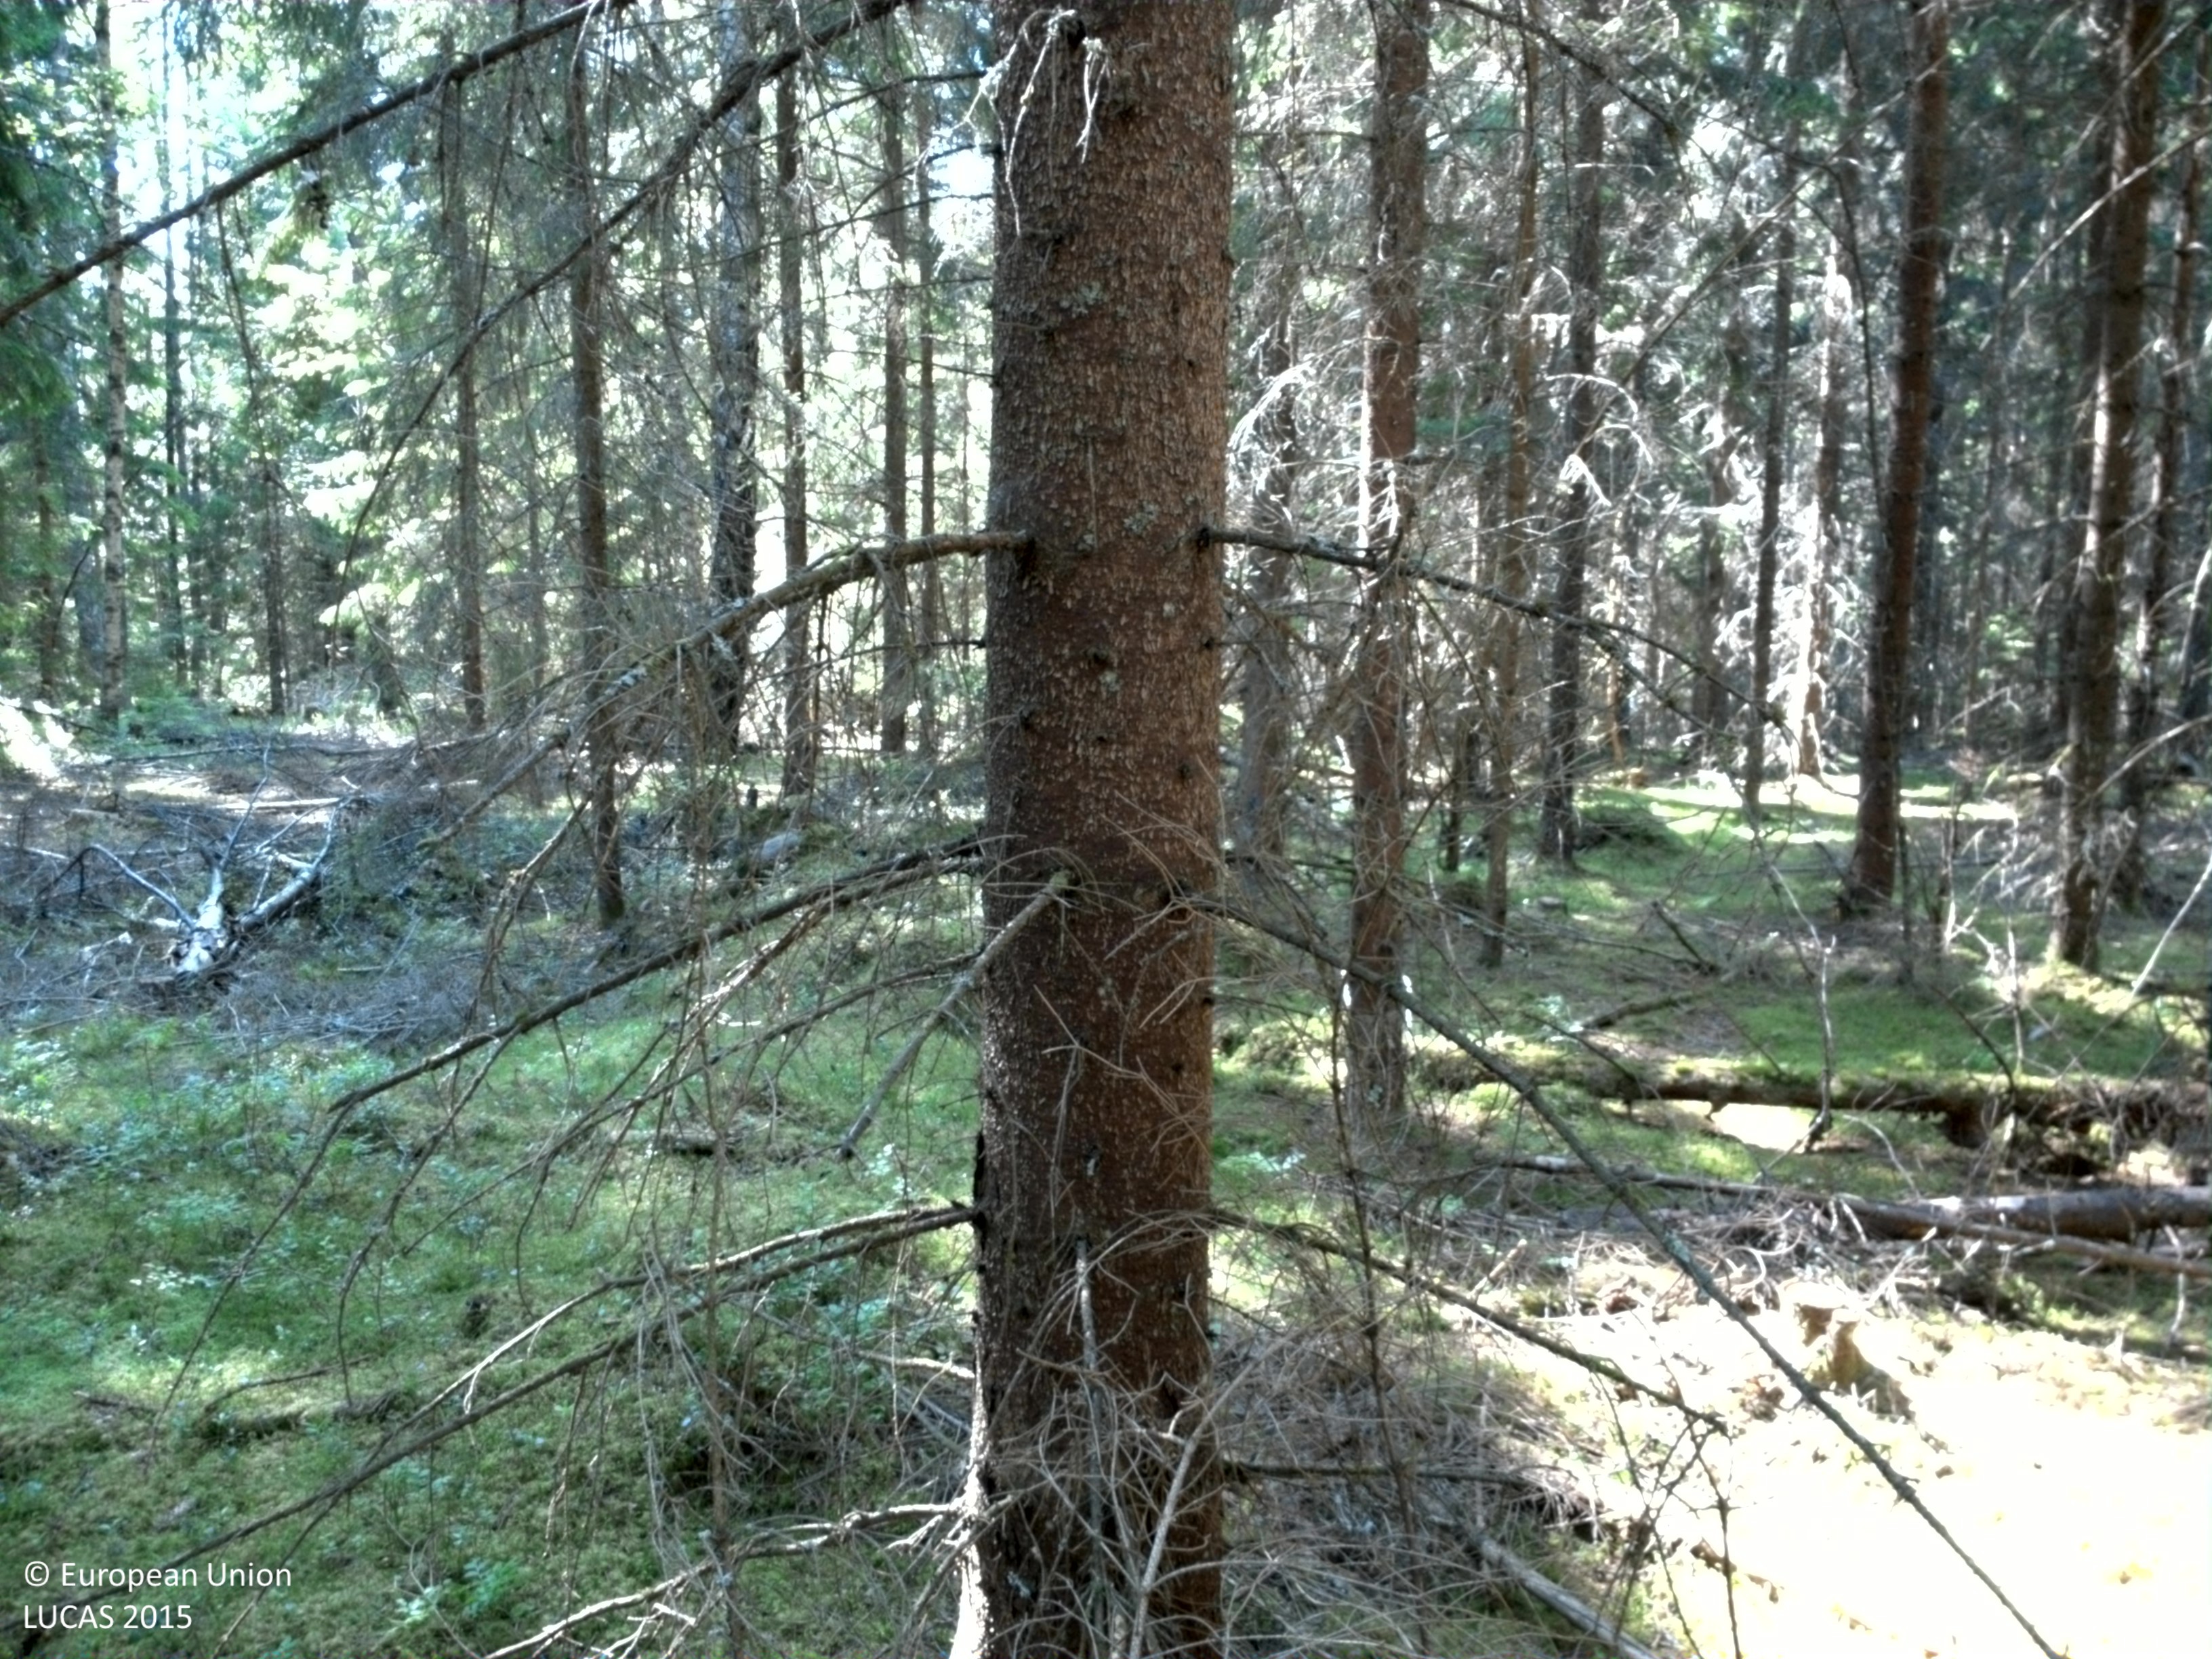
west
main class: Woodland
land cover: Spruce dominated coniferous woodland
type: boreal forest
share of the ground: 25 - 50 %
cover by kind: coniferous forest trees 40 %, lichens and mosses 40 %, herbaceous plants 20 %
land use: Forestry
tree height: > 5 m
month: July
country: SE
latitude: 58.7208
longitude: 14.4999
